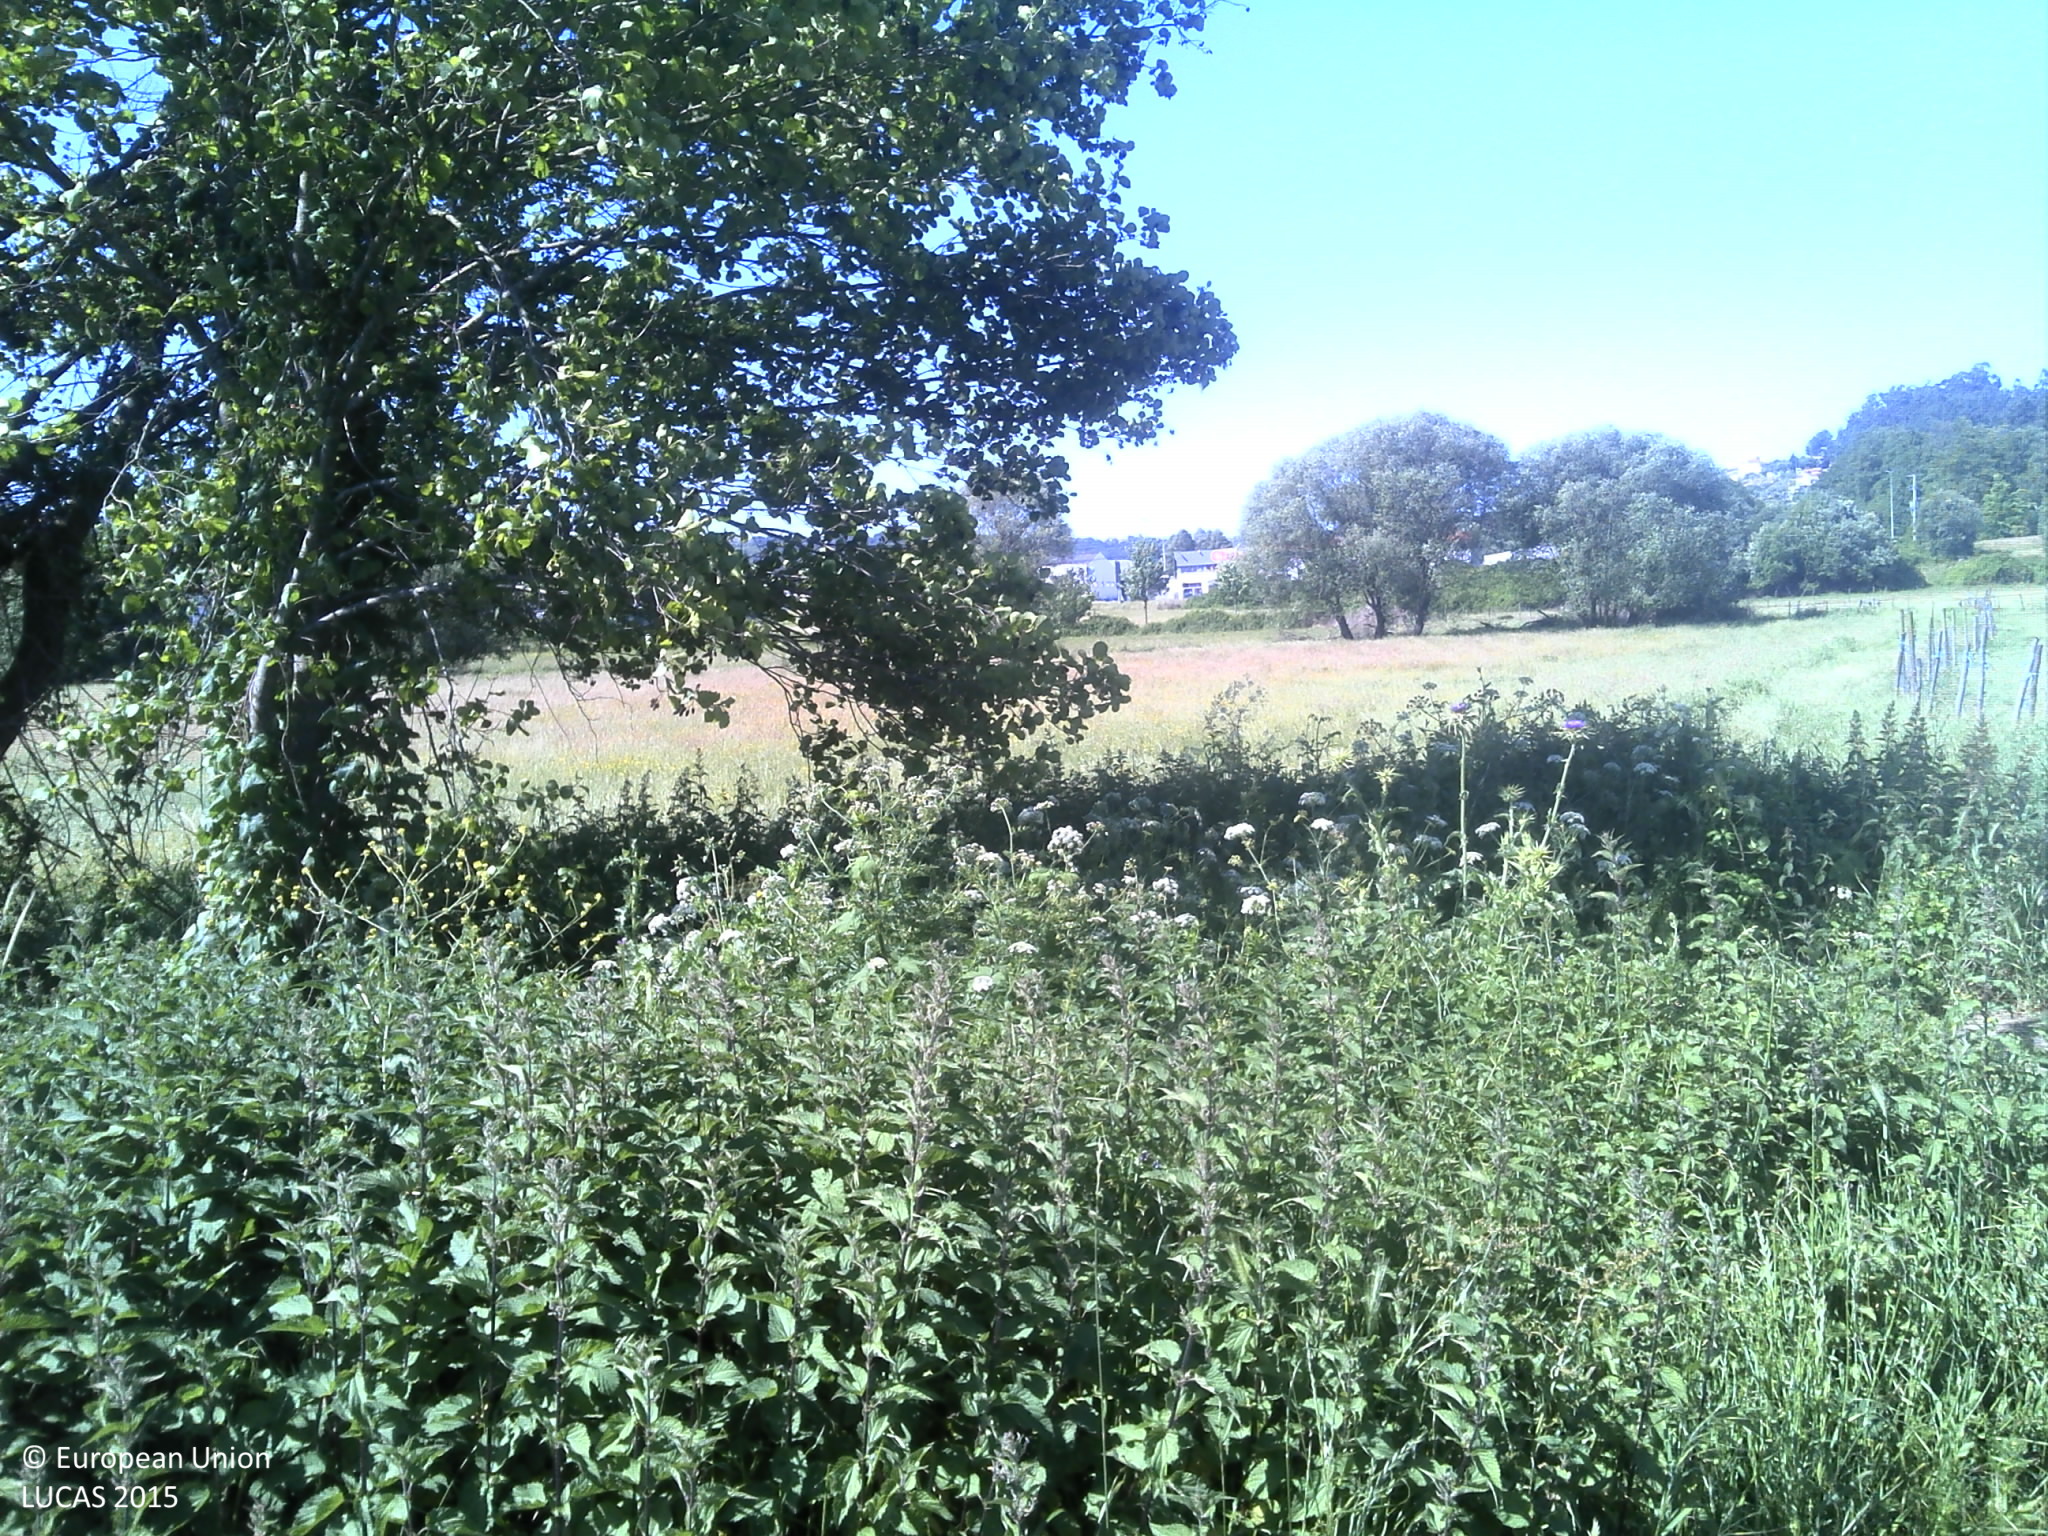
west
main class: Grassland
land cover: Grassland without tree/shrub cover
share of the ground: > 75 %
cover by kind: herbaceous plants 90 %, unconsolidated bare surface 10 %
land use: Agriculture (excluding fallow land and kitchen gardens)
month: May
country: PT
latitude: 40.4319
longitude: -7.7146
